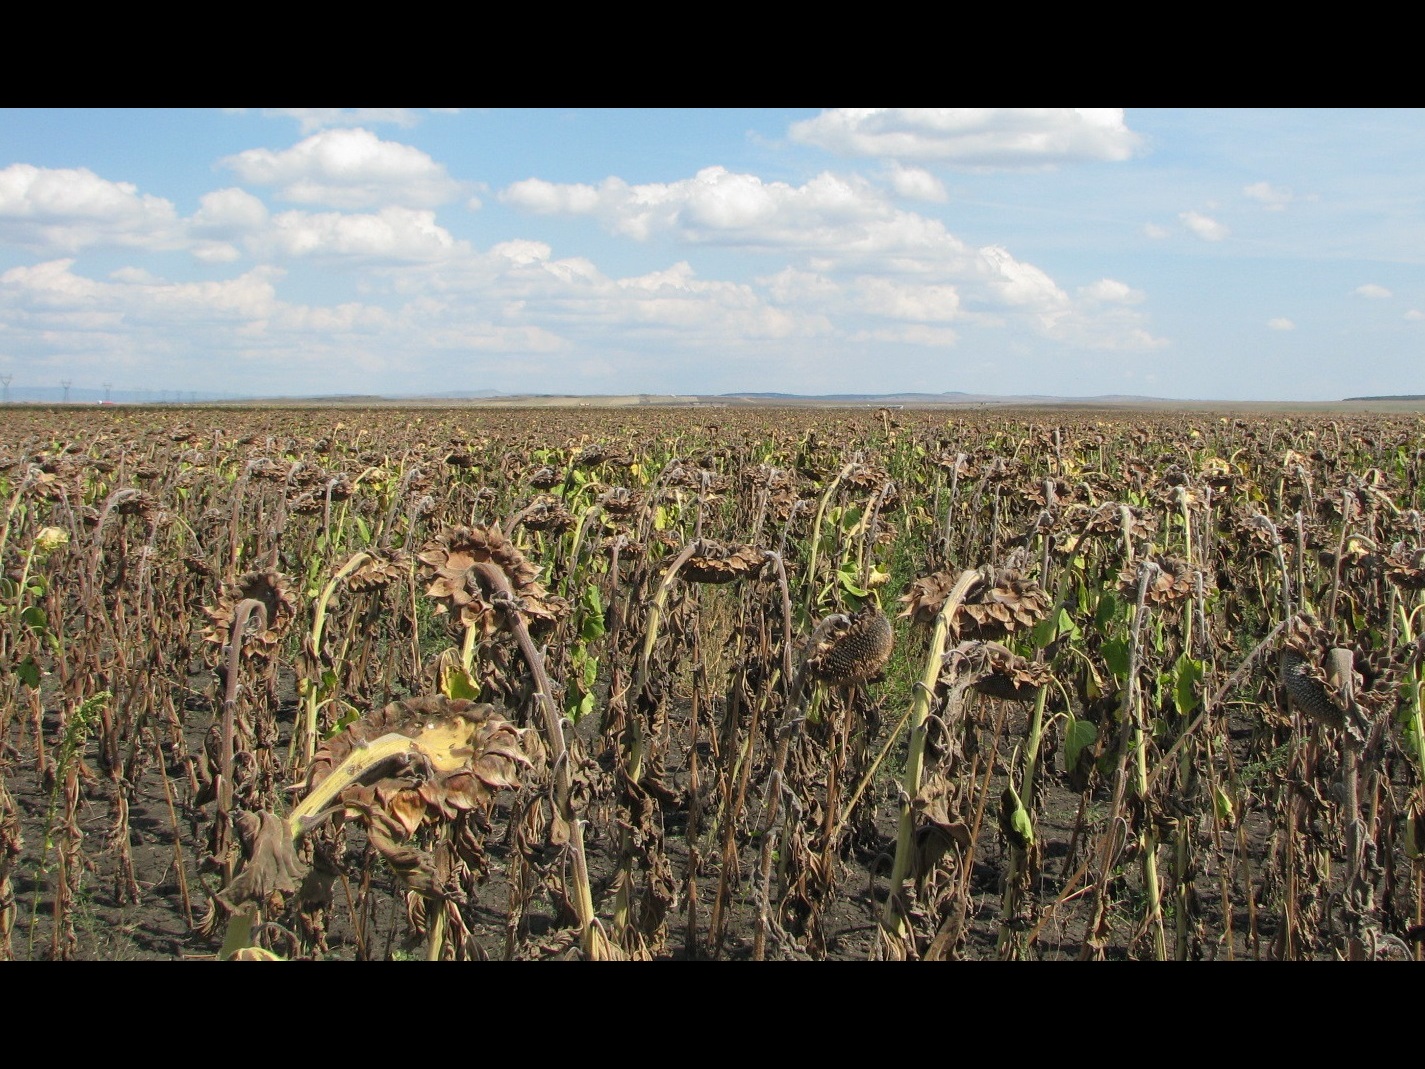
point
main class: Cropland
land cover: Sunflower
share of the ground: > 75 %
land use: Agriculture (excluding fallow land and kitchen gardens)
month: September
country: BG
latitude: 42.5409
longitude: 26.7190
